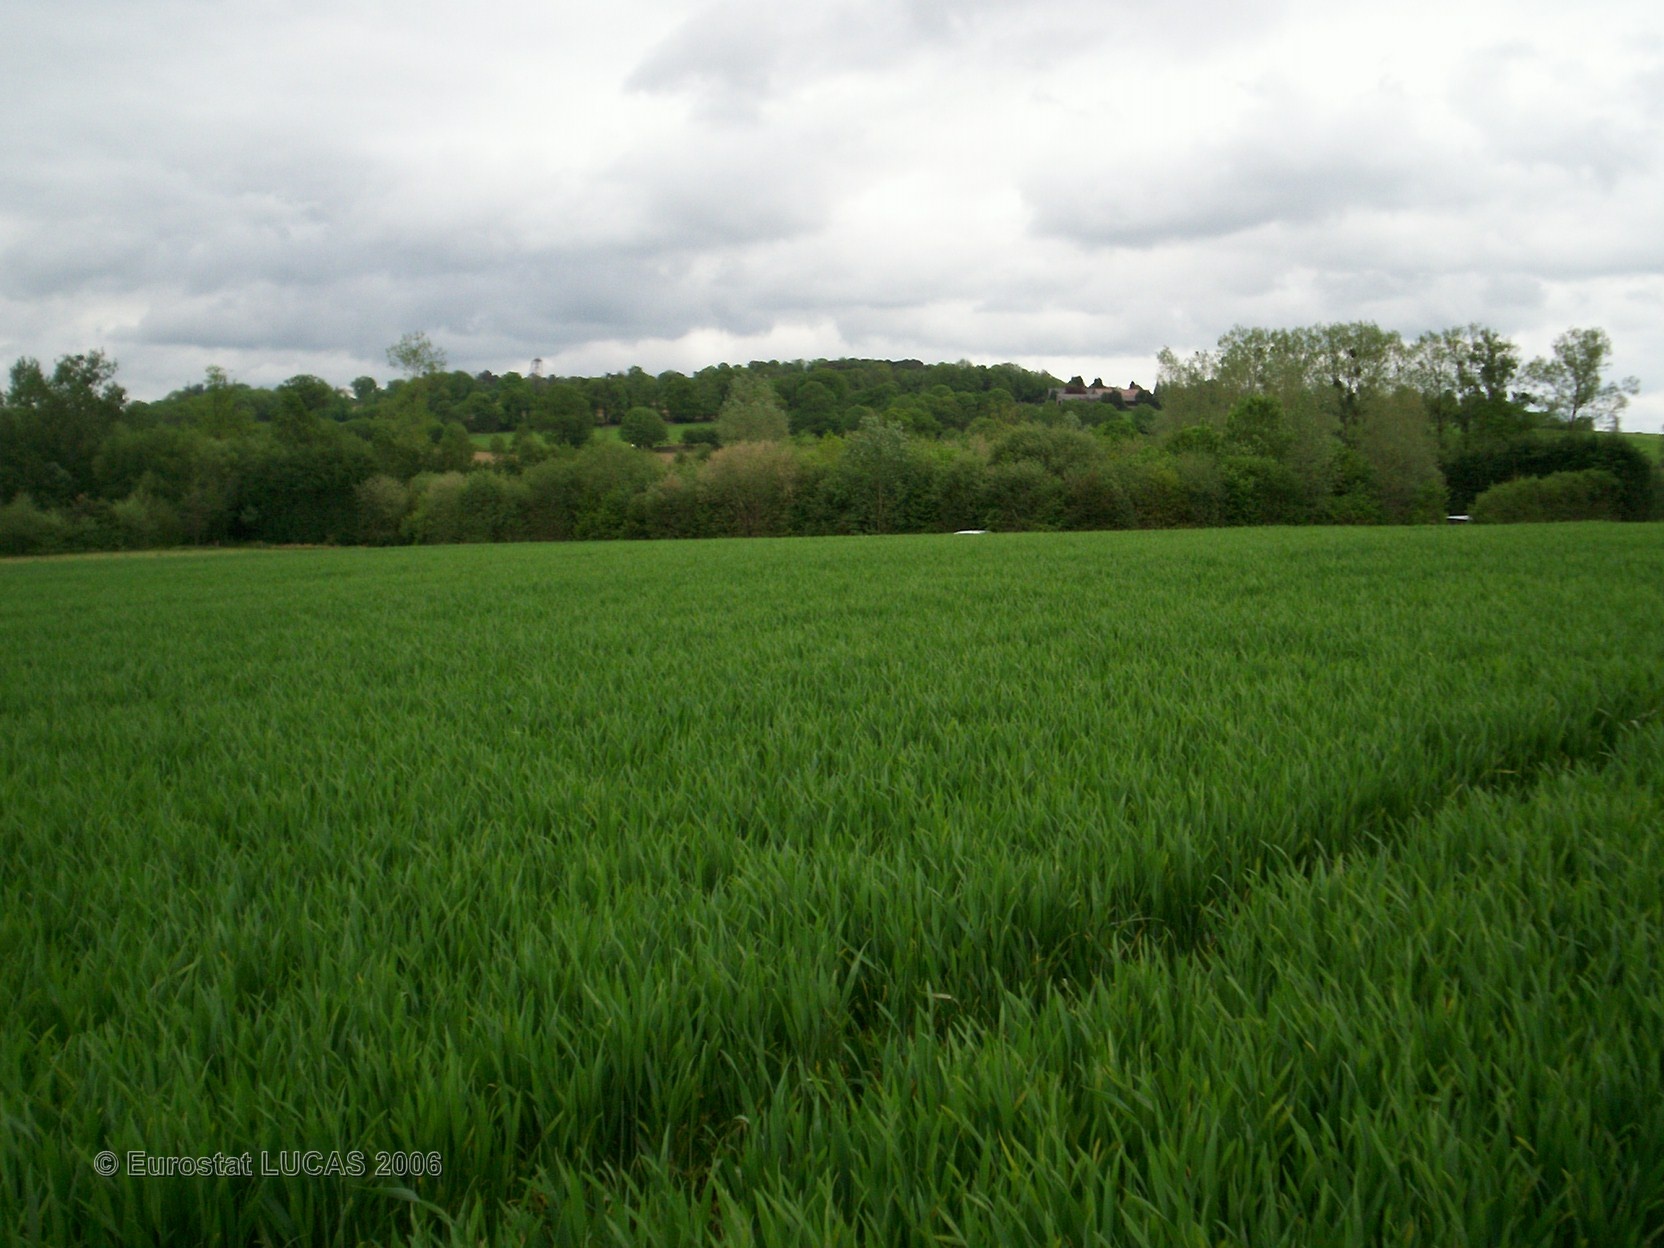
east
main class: Cropland
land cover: Common wheat
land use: Agriculture (excluding fallow land and kitchen gardens)
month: May
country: FR
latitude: 48.2878
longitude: -1.1882
